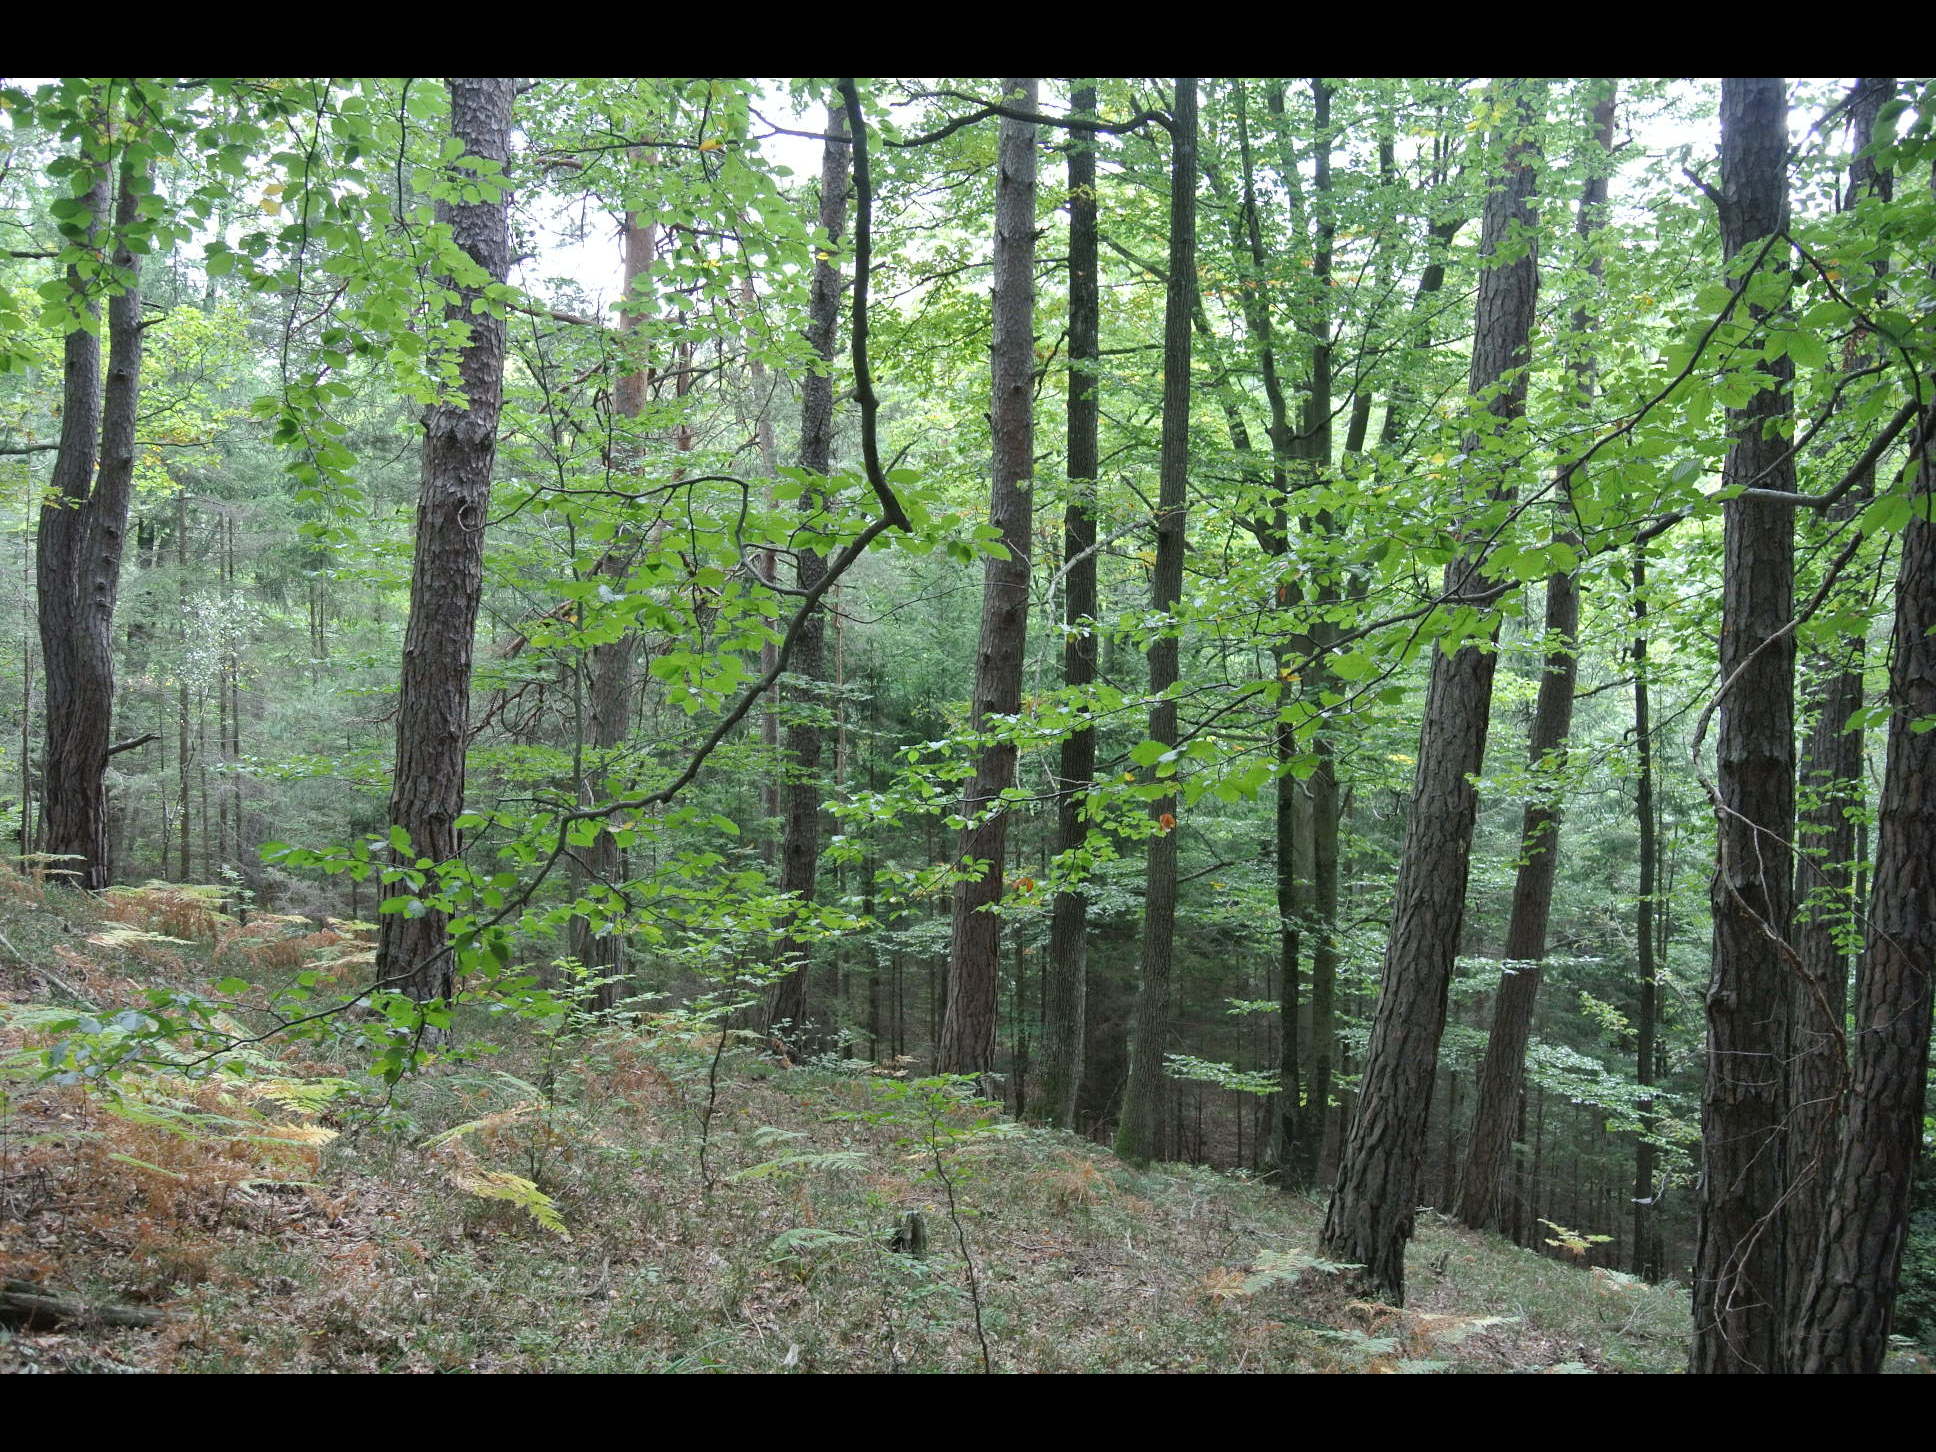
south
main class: Woodland
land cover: Pine dominated mixed woodland
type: alpine coniferous forest
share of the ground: > 75 %
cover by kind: coniferous forest trees 50 %, broadleaved forest trees 50 %
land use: Forestry
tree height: > 5 m
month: September
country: AT
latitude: 47.3876
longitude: 16.4015
